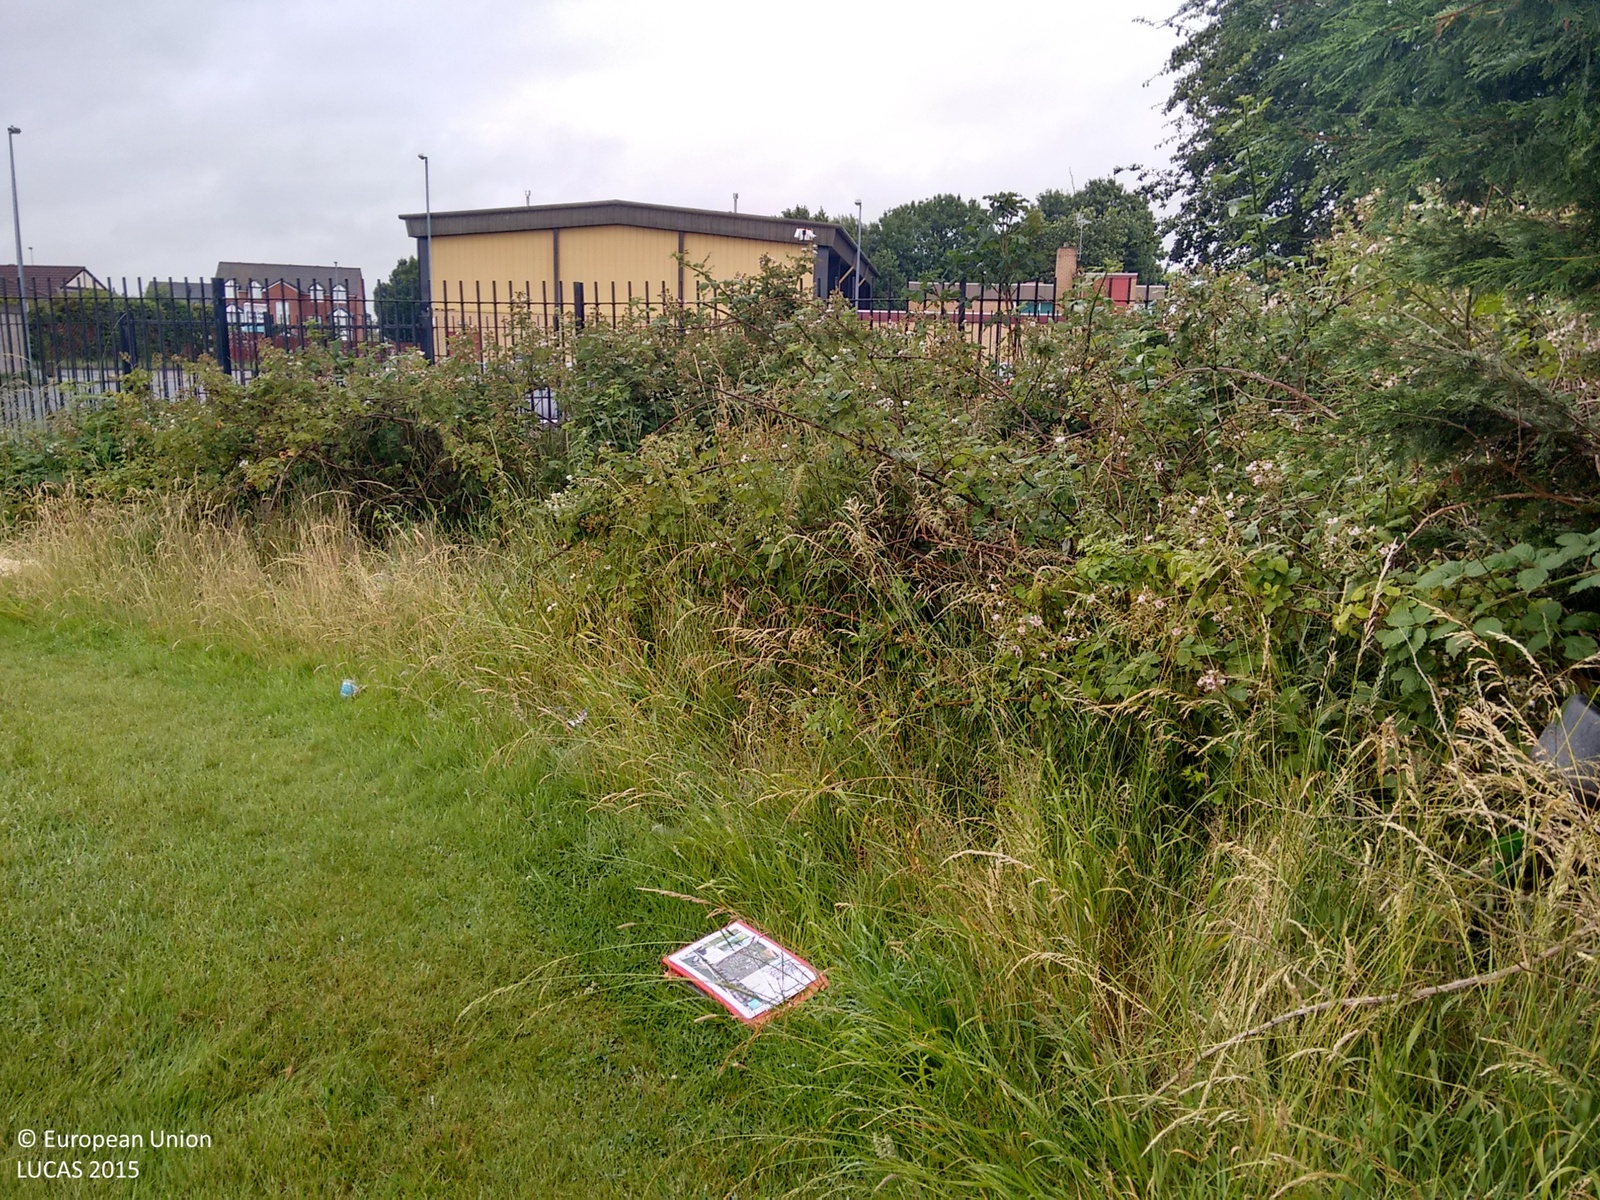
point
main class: Grassland
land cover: Grassland with sparse tree/shrub cover
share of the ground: > 75 %
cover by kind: herbaceous plants 95 %, broadleaved forest trees 5 %
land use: Amenities, museums, leisure
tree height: > 5 m
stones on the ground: < 10 %
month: July
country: GB
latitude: 53.3777
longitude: -2.7725
